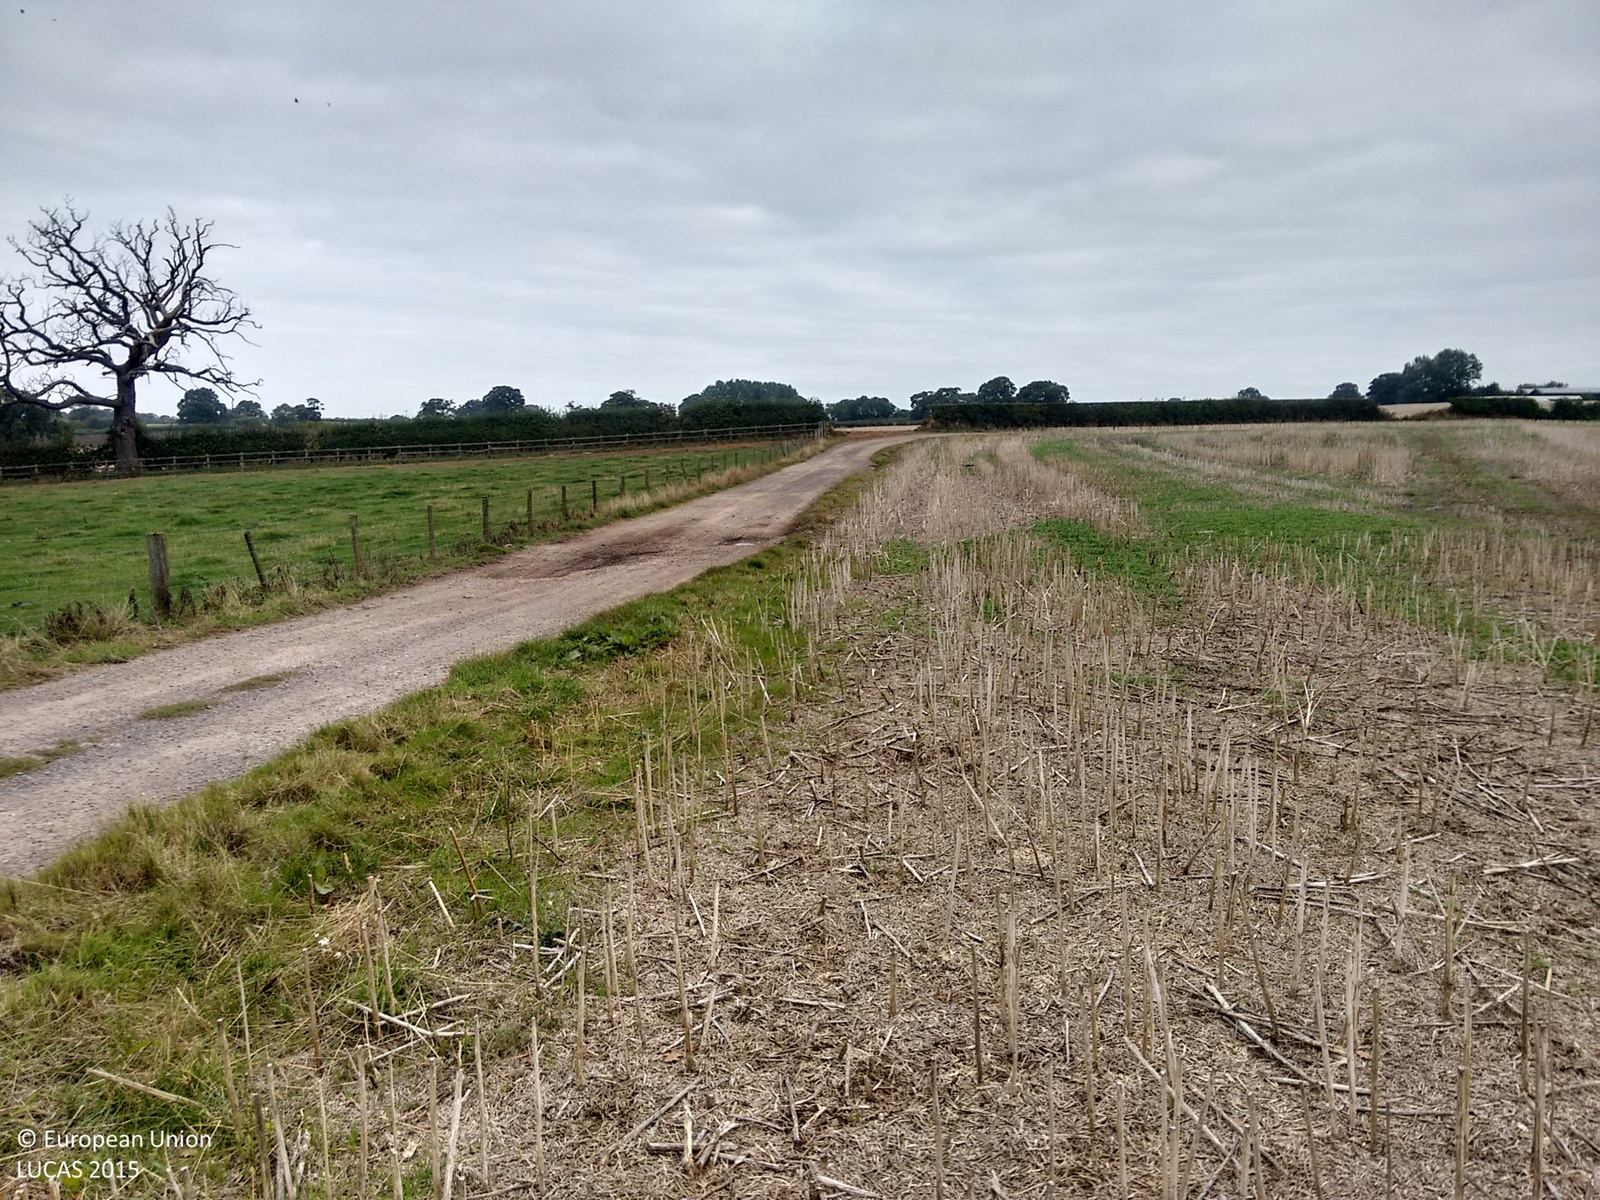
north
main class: Cropland
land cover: Rape and turnip rape
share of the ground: < 10 %
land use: Agriculture (excluding fallow land and kitchen gardens)
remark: Harvested field
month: September
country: GB
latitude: 52.9113
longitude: -2.8757
